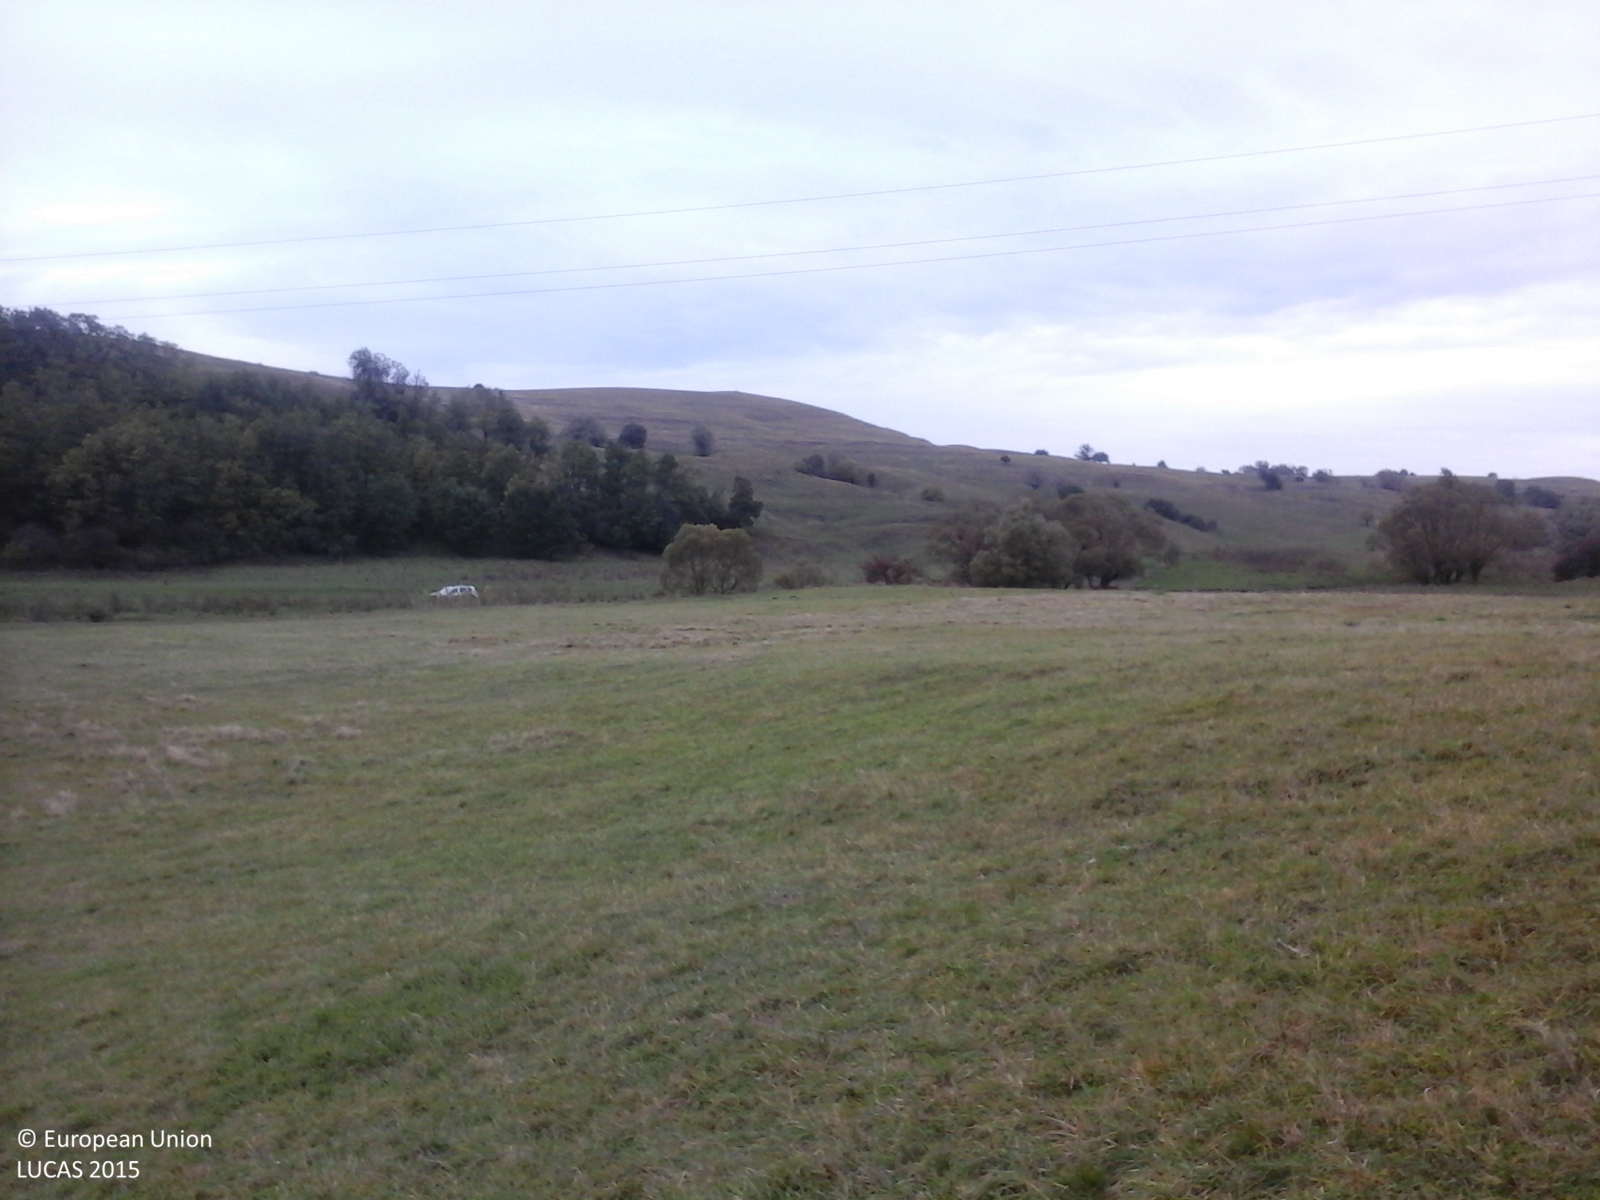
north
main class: Grassland
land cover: Grassland without tree/shrub cover
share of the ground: > 75 %
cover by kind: herbaceous plants 100 %
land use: Agriculture (excluding fallow land and kitchen gardens)
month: October
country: RO
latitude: 46.0309
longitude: 24.9108
